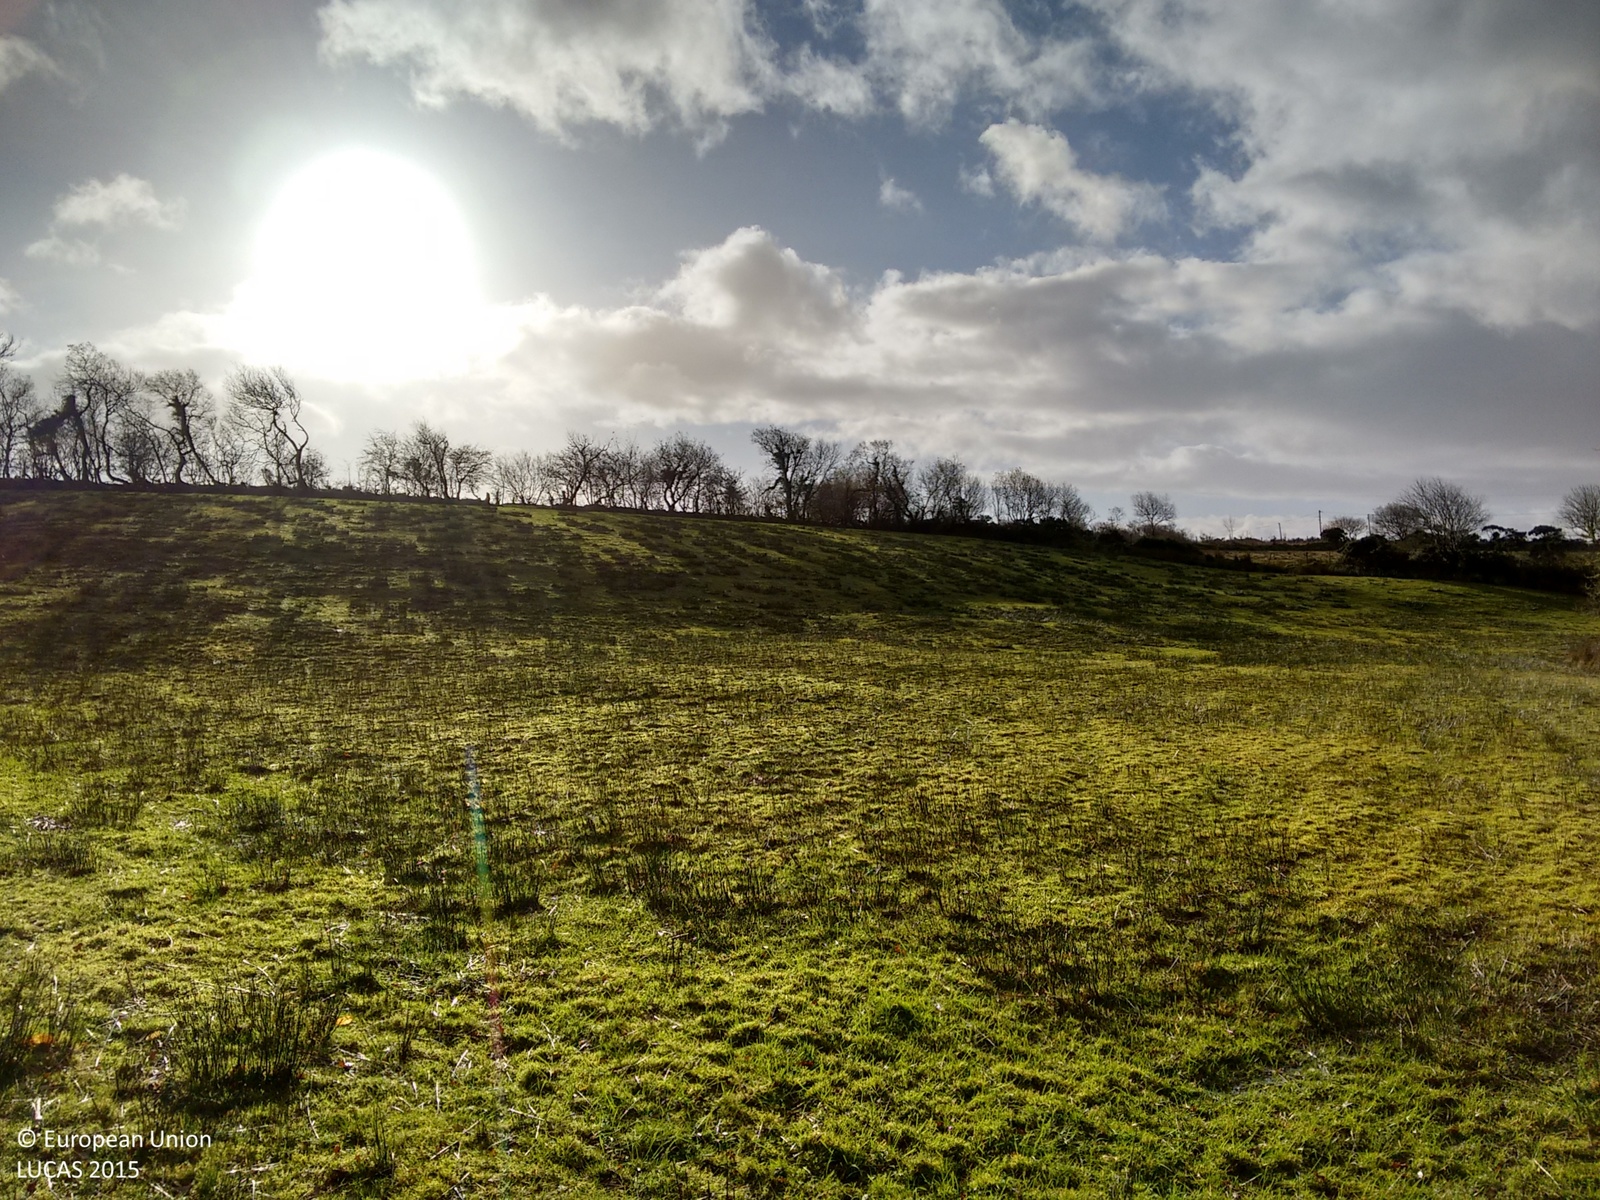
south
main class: Grassland
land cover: Grassland without tree/shrub cover
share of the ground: > 75 %
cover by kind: herbaceous plants 100 %
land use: Agriculture (excluding fallow land and kitchen gardens)
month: November
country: IE
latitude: 54.6681
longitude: -8.1804
